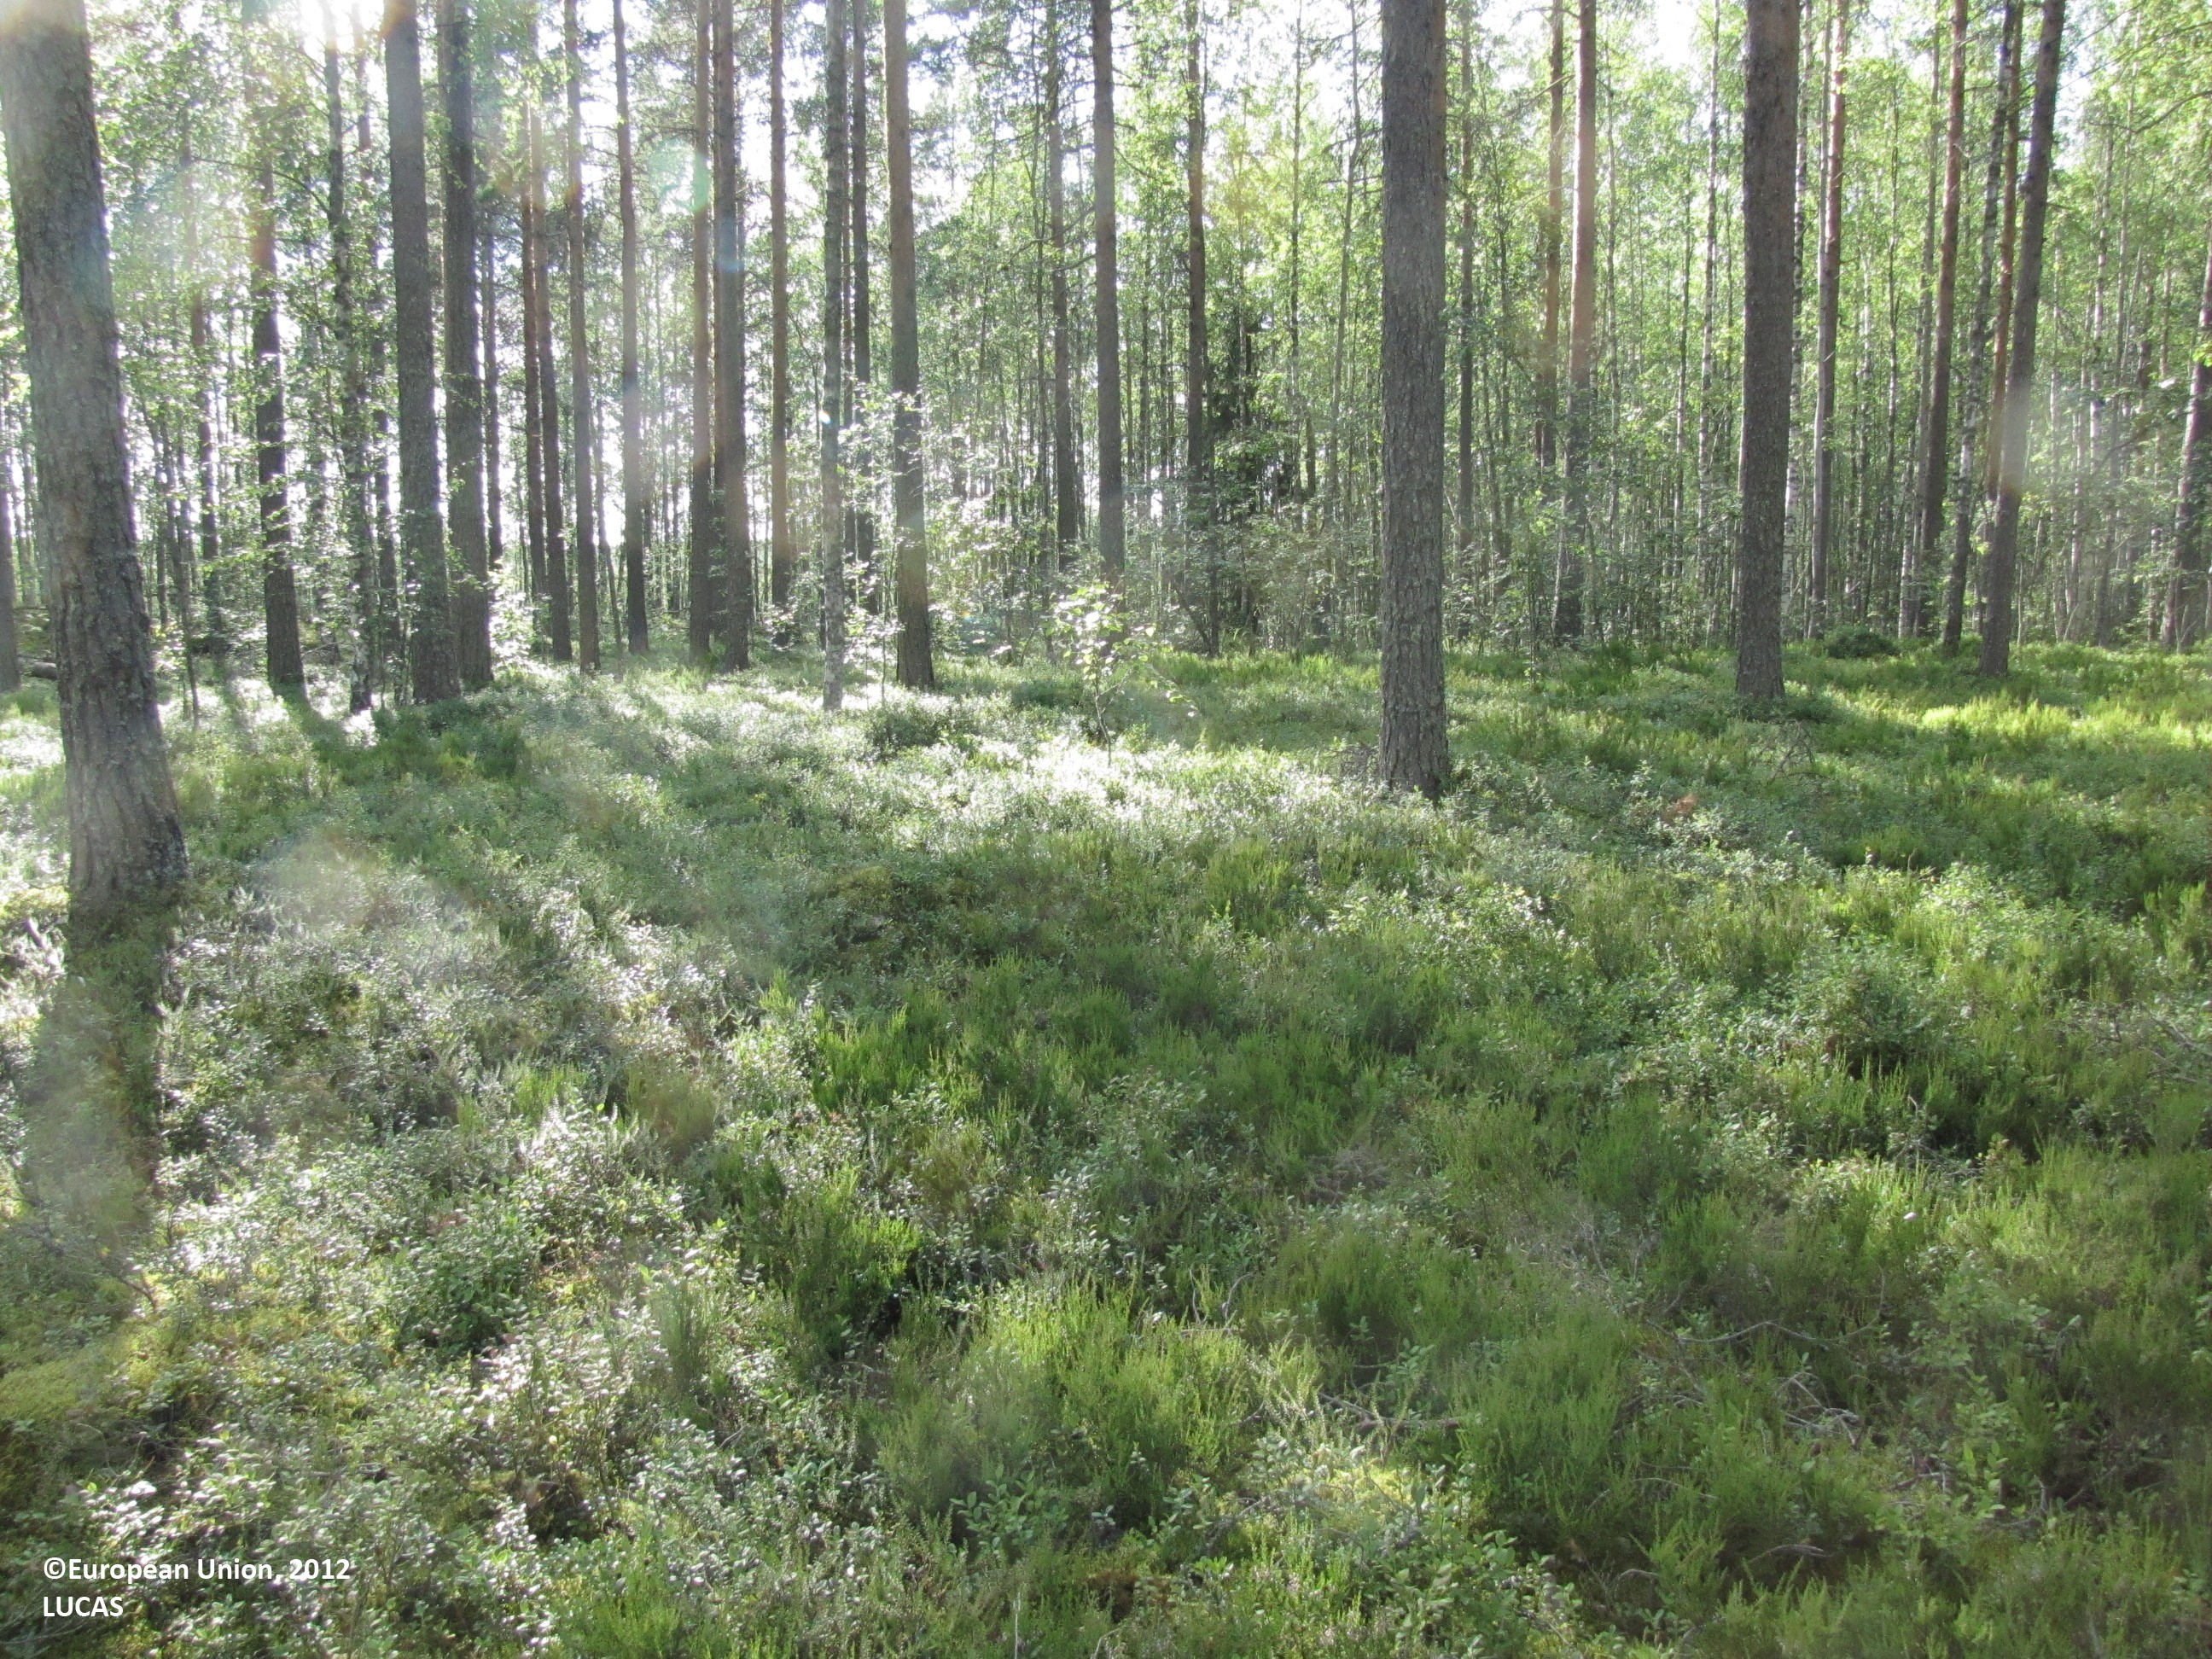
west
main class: Woodland
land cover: Pine dominated coniferous woodland
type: boreal forest
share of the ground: > 75 %
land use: Forestry
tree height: > 5 m
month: July
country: FI
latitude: 62.3625
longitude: 23.1486
